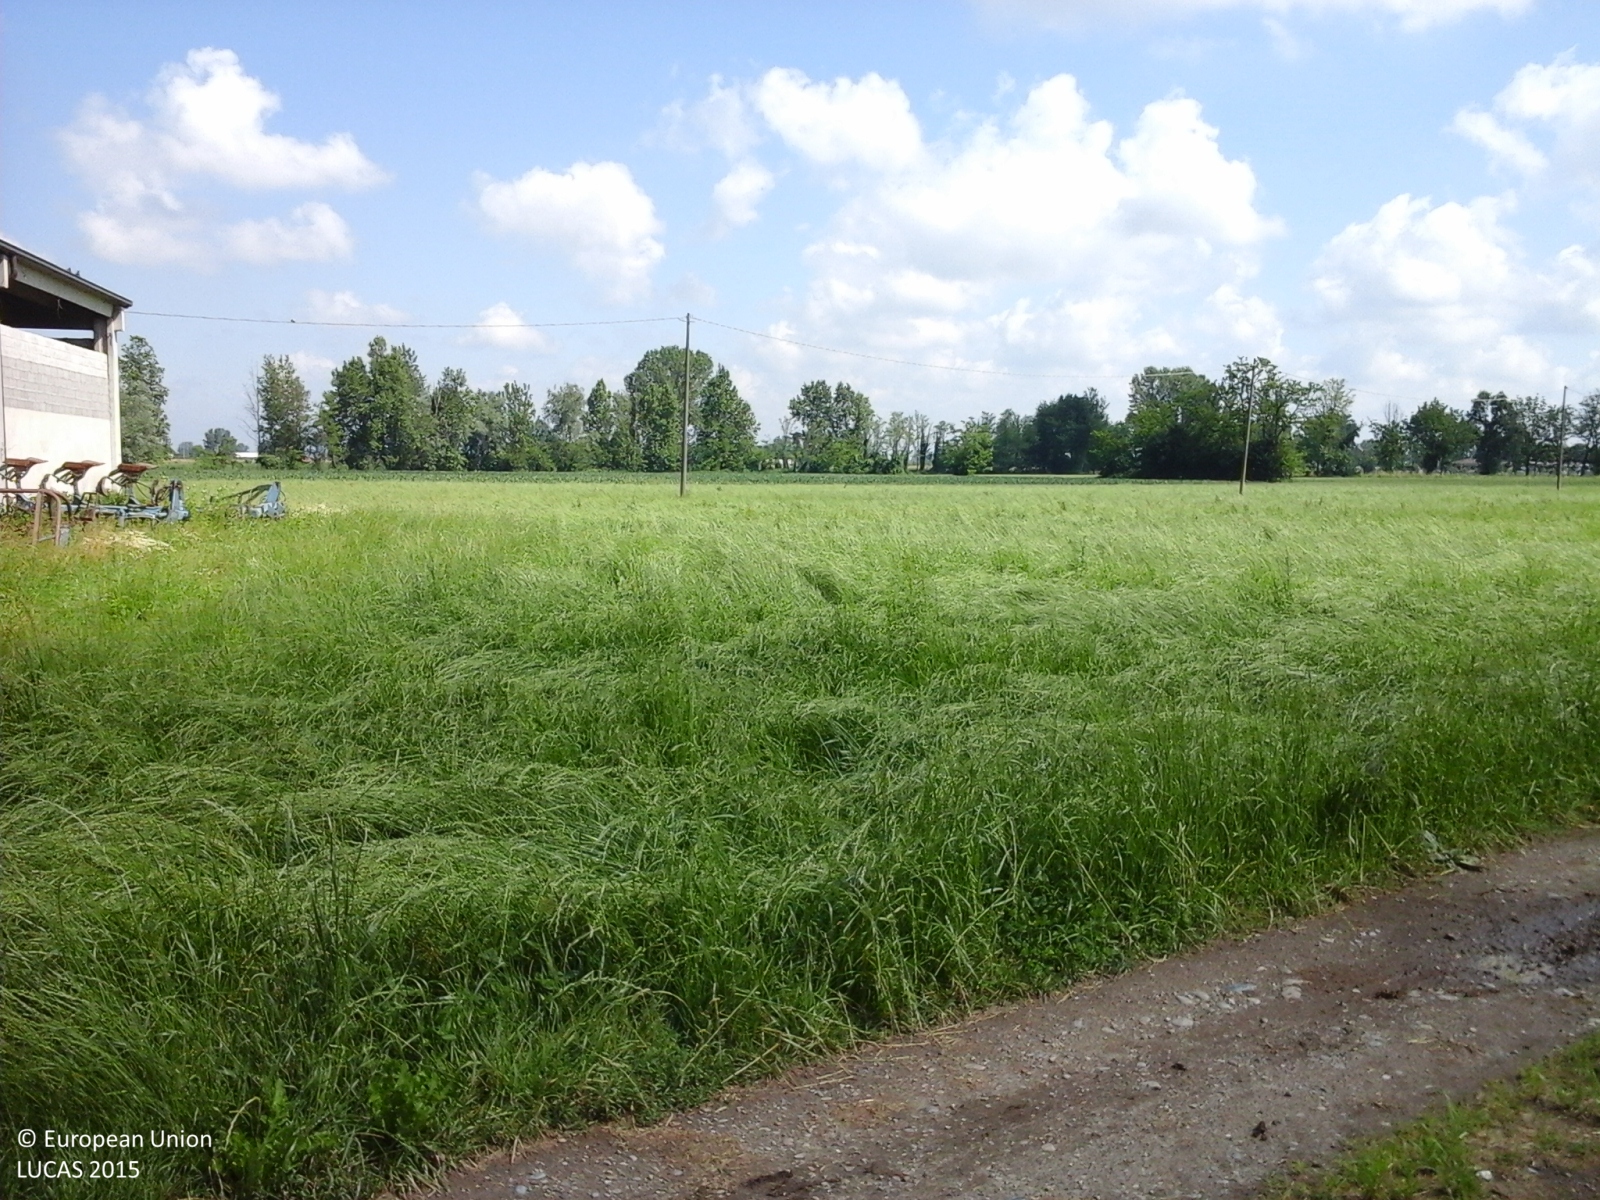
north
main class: Cropland
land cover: Maize
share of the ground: > 75 %
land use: Agriculture (excluding fallow land and kitchen gardens)
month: May
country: IT
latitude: 45.3773
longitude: 9.5538
